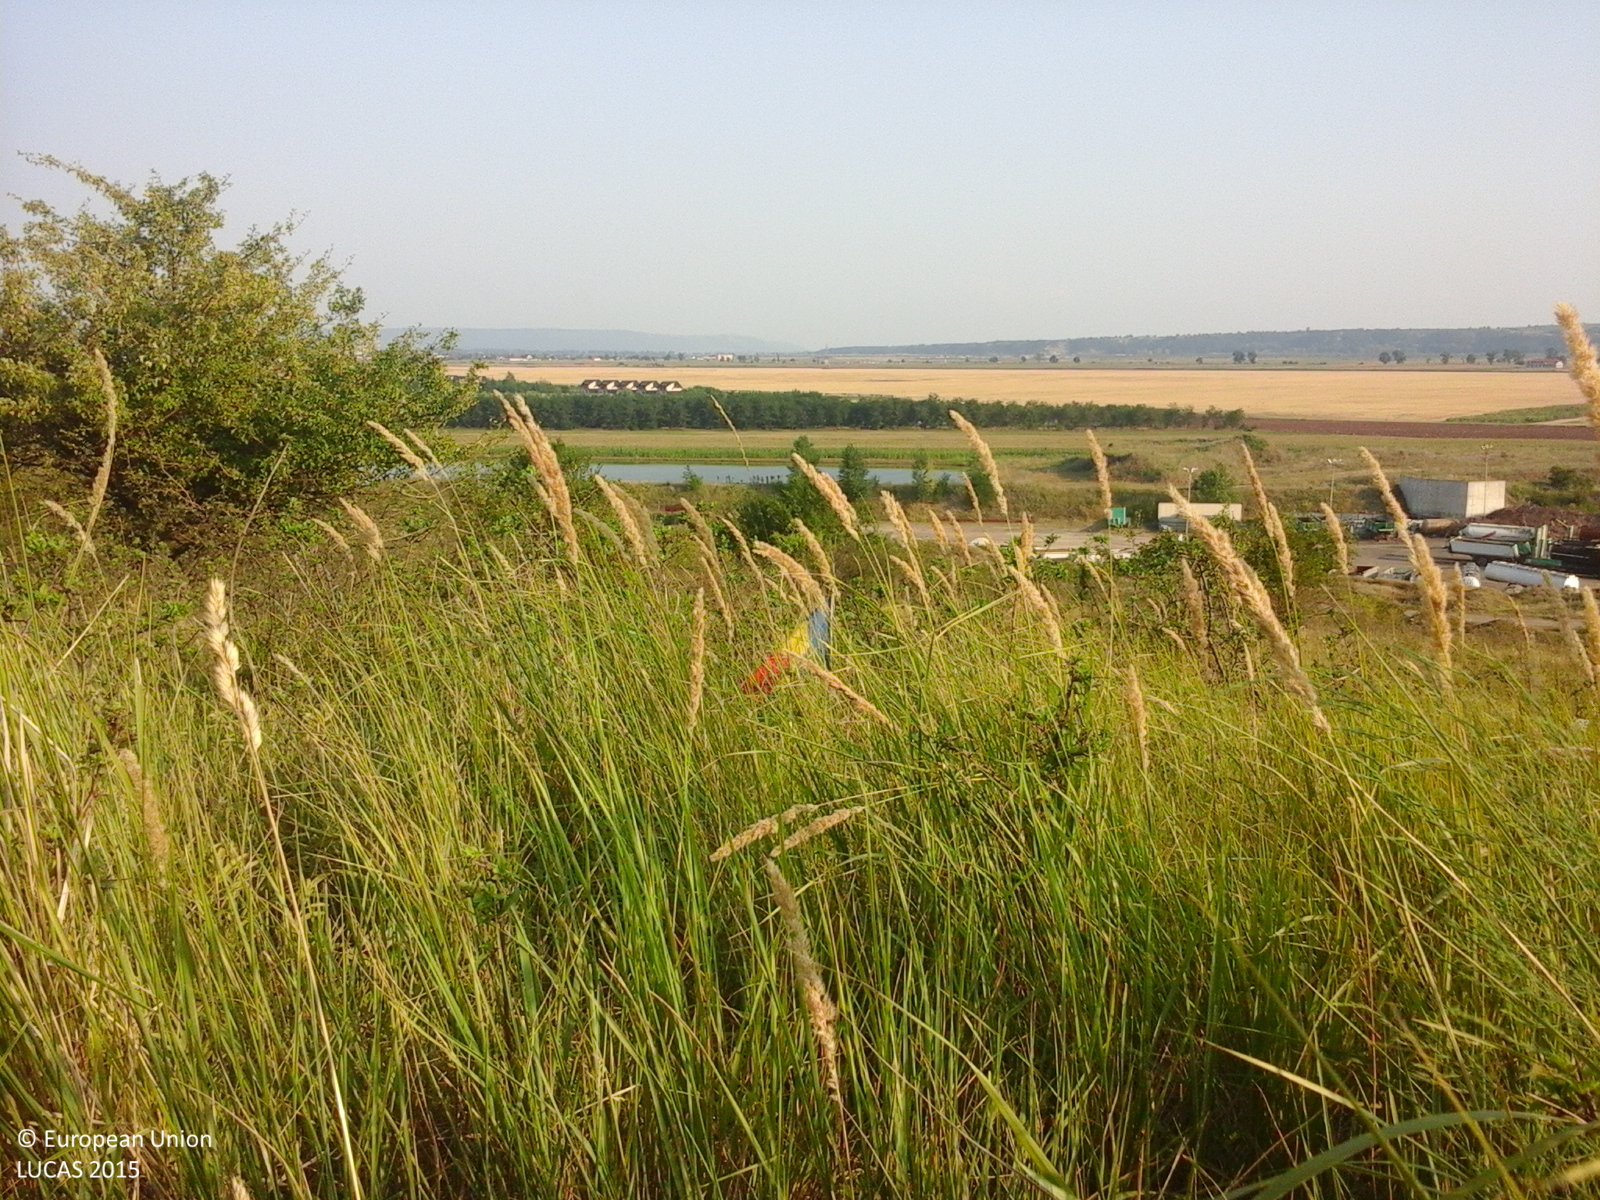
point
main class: Grassland
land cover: Grassland with sparse tree/shrub cover
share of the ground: > 75 %
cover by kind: herbaceous plants 95 %, broadleaved forest trees 5 %
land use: Agriculture (excluding fallow land and kitchen gardens)
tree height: < 5 m
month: July
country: RO
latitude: 46.1313
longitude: 27.1432
